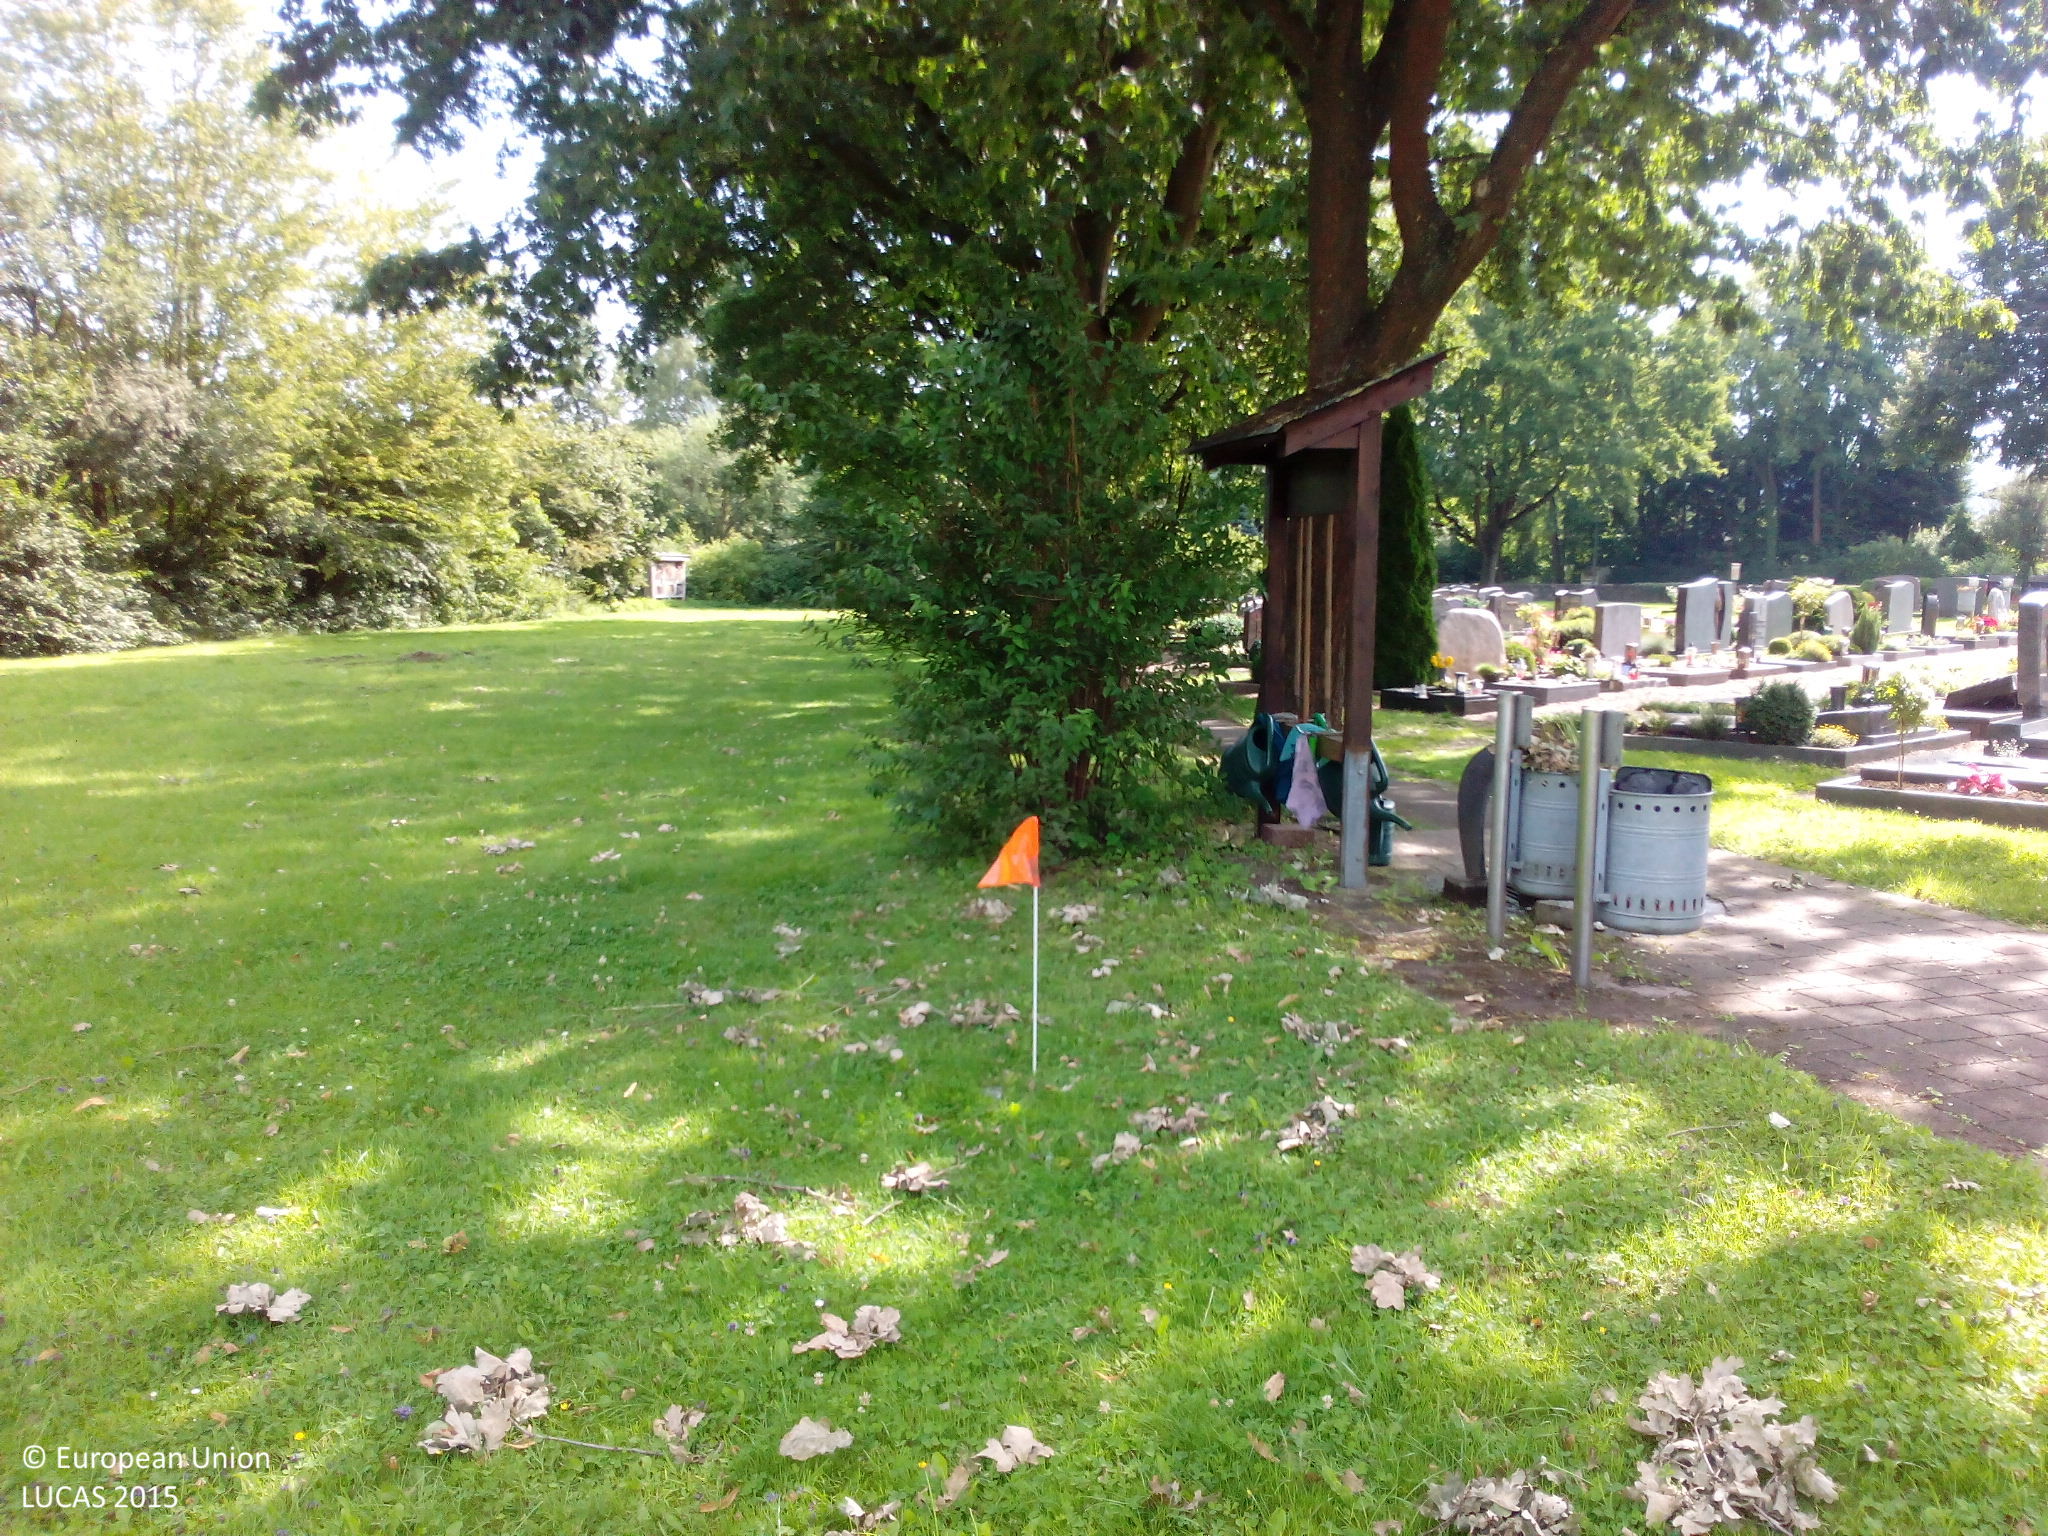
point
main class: Grassland
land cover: Grassland with sparse tree/shrub cover
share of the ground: > 75 %
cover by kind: herbaceous plants 95 %, broadleaved forest trees 5 %
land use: Community services
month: August
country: DE
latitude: 51.8005
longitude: 9.3477
